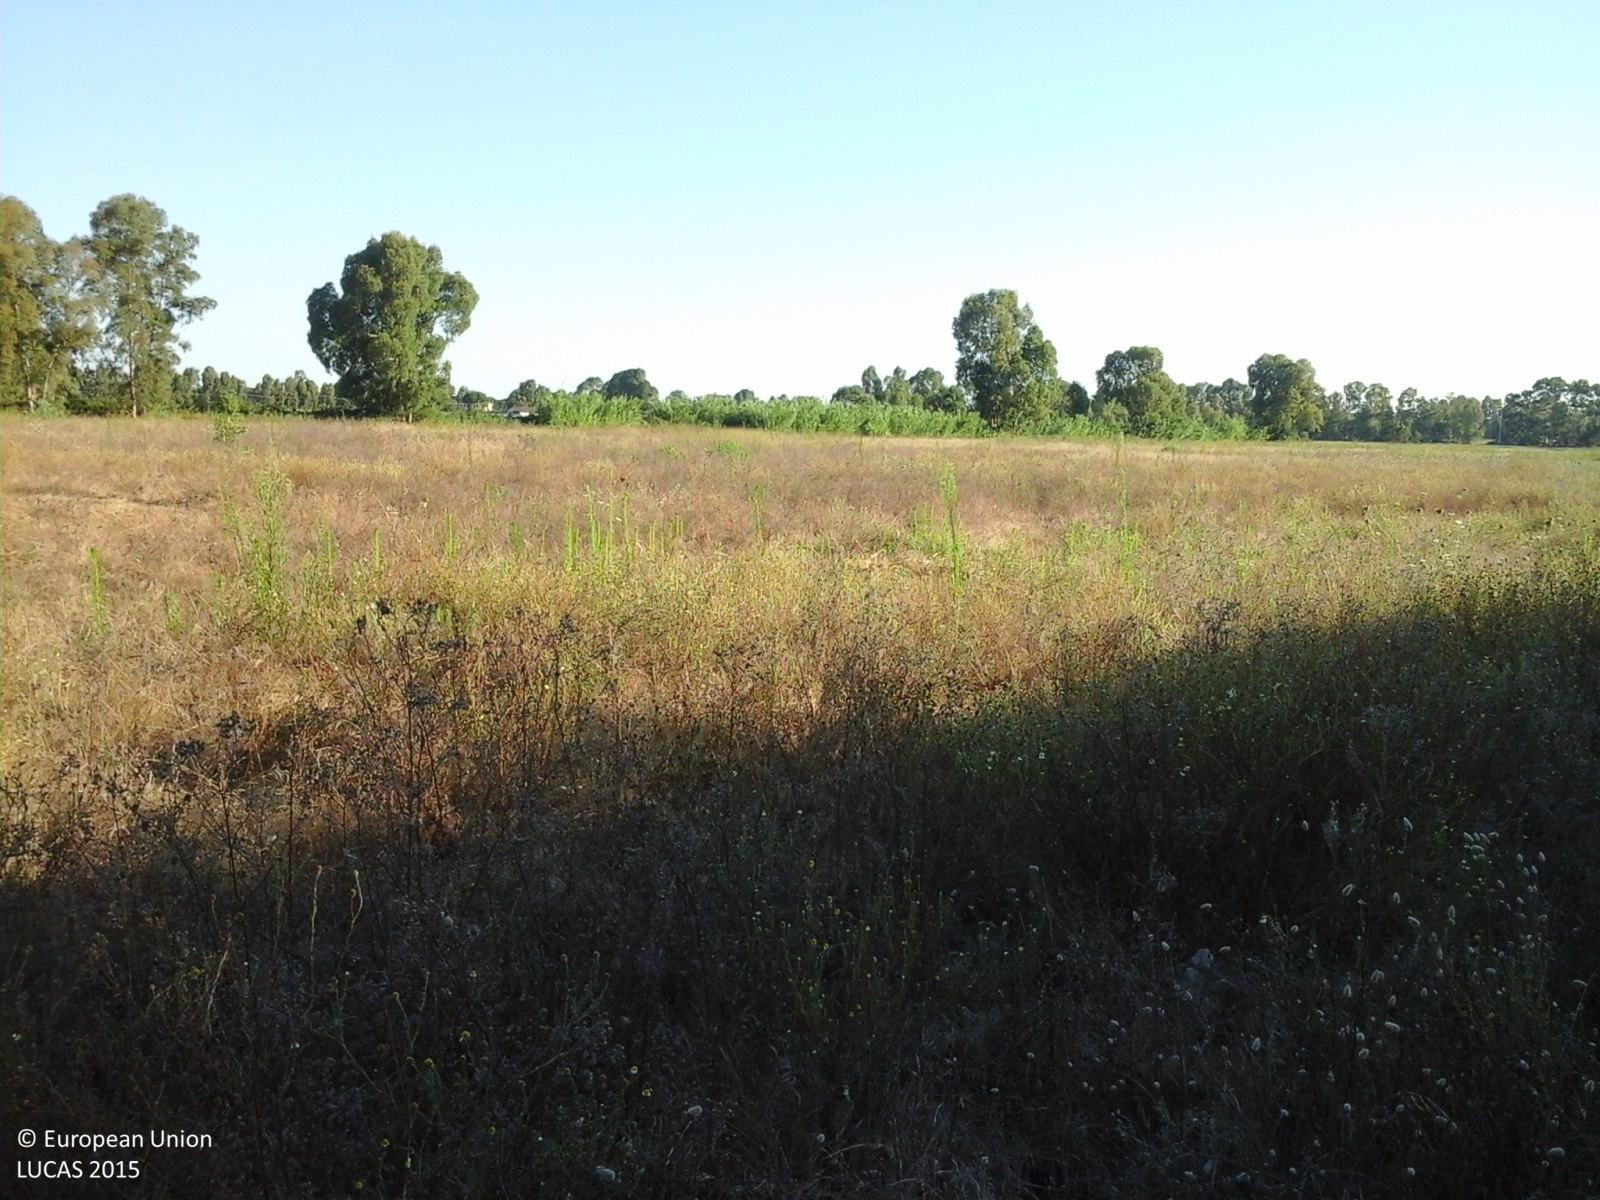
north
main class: Grassland
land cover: Grassland without tree/shrub cover
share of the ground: > 75 %
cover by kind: herbaceous plants 100 %
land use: Agriculture (excluding fallow land and kitchen gardens)
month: August
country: IT
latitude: 42.4660
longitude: 11.2241
